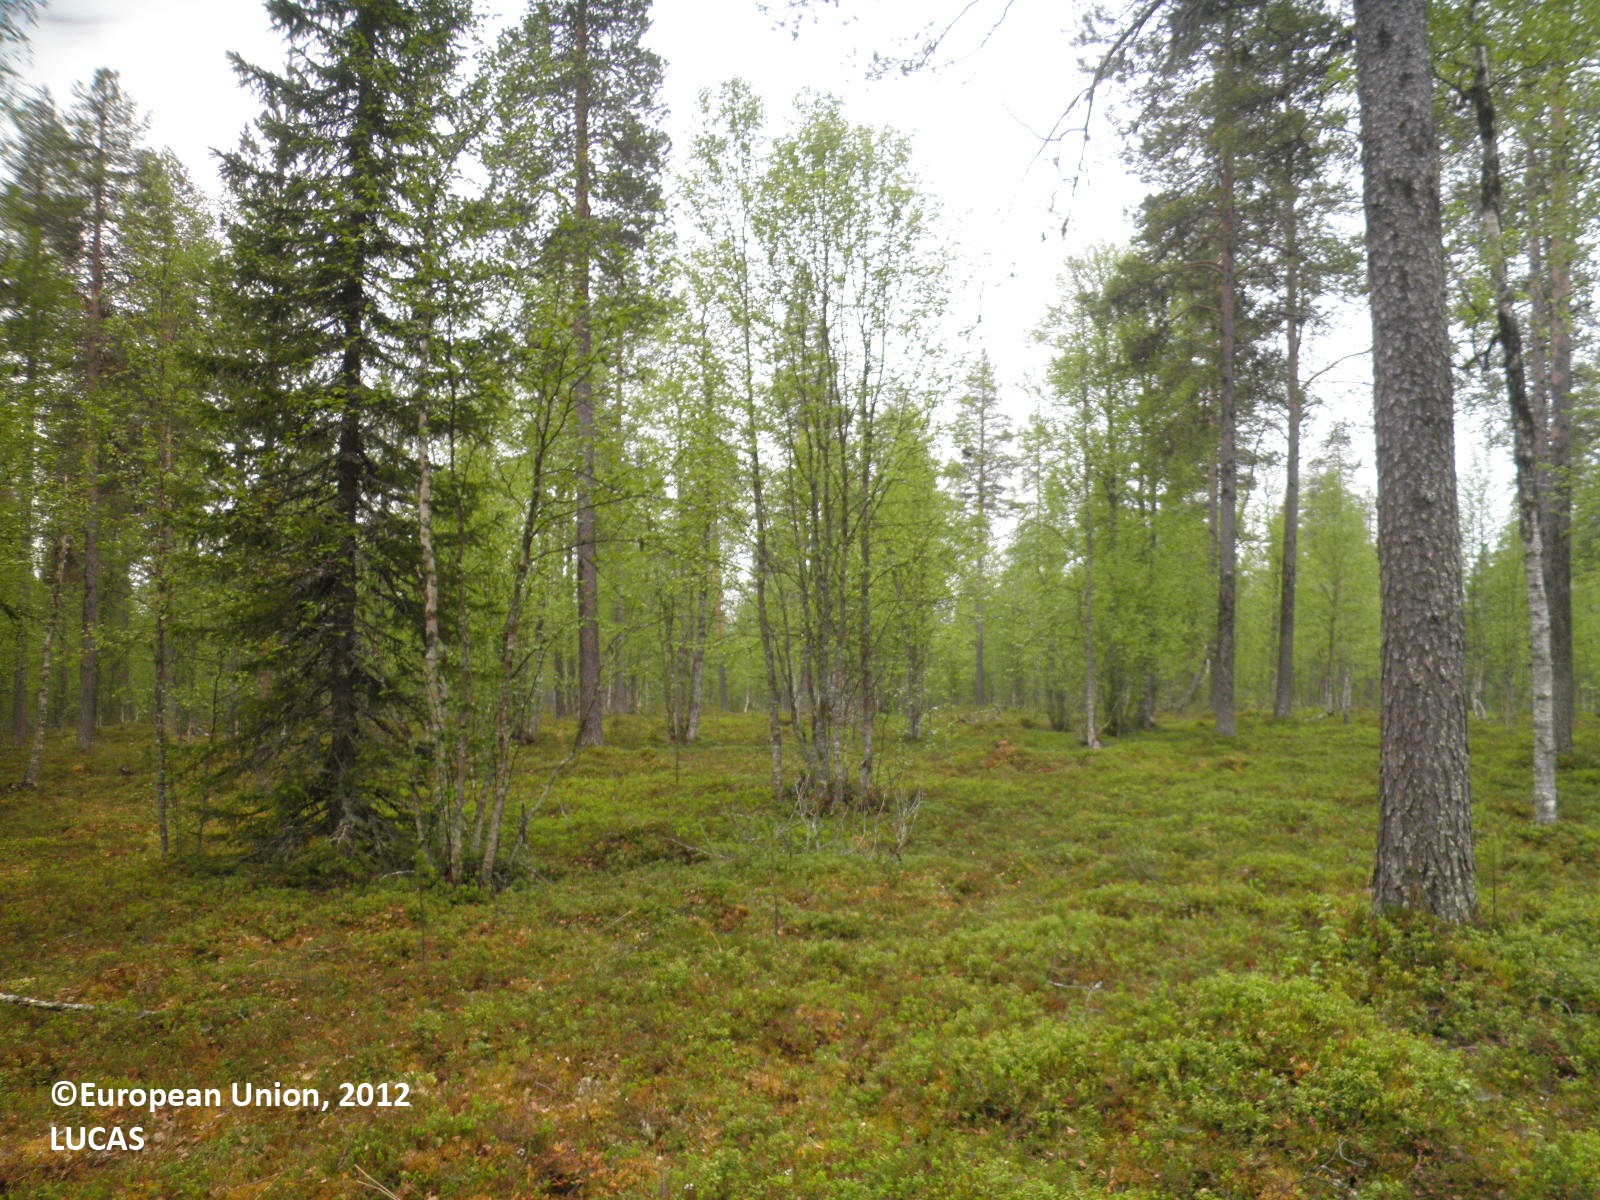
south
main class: Woodland
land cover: Pine dominated mixed woodland
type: boreal forest
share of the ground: 25 - 50 %
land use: Forestry
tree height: > 5 m
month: June
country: FI
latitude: 67.9312
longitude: 25.4728
